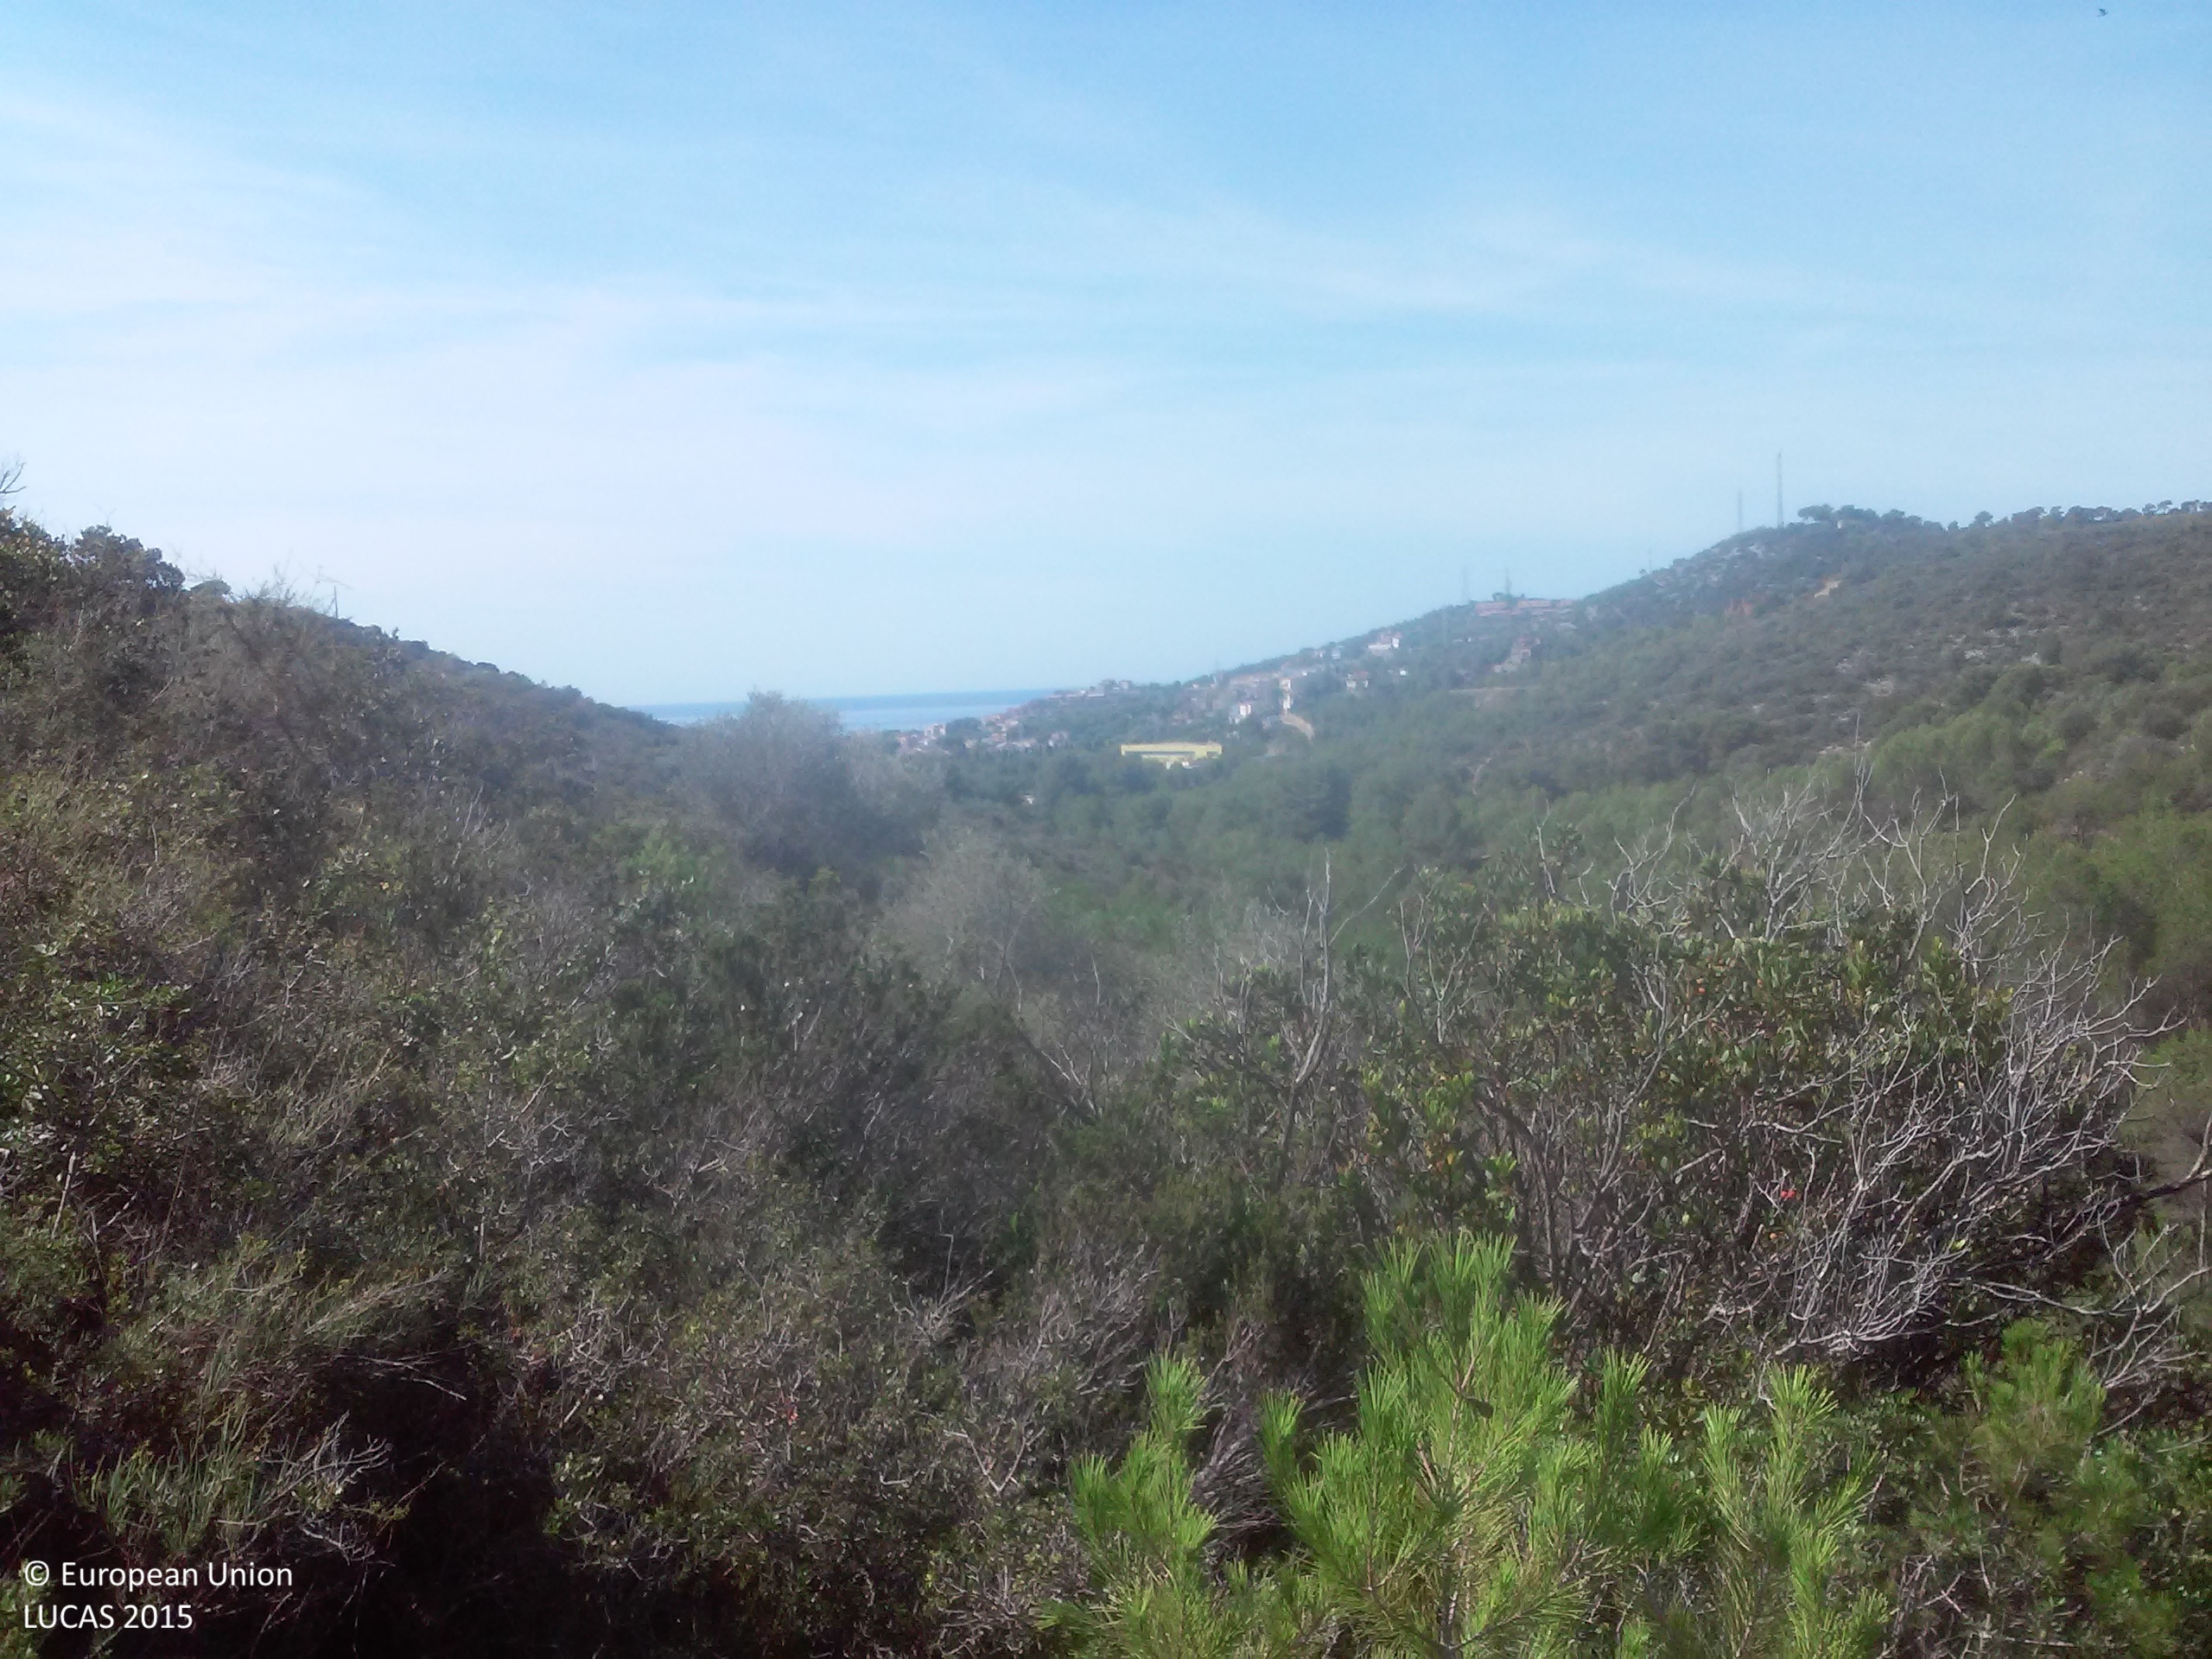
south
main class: Shrubland
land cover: Shrubland with sparse tree cover
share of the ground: 25 - 50 %
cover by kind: shrubs 75 %, herbaceous plants 20 %, broadleaved forest trees 5 %
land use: Semi-natural and natural areas not in use
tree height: < 5 m
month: September
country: ES
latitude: 41.2160
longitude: 1.6092
